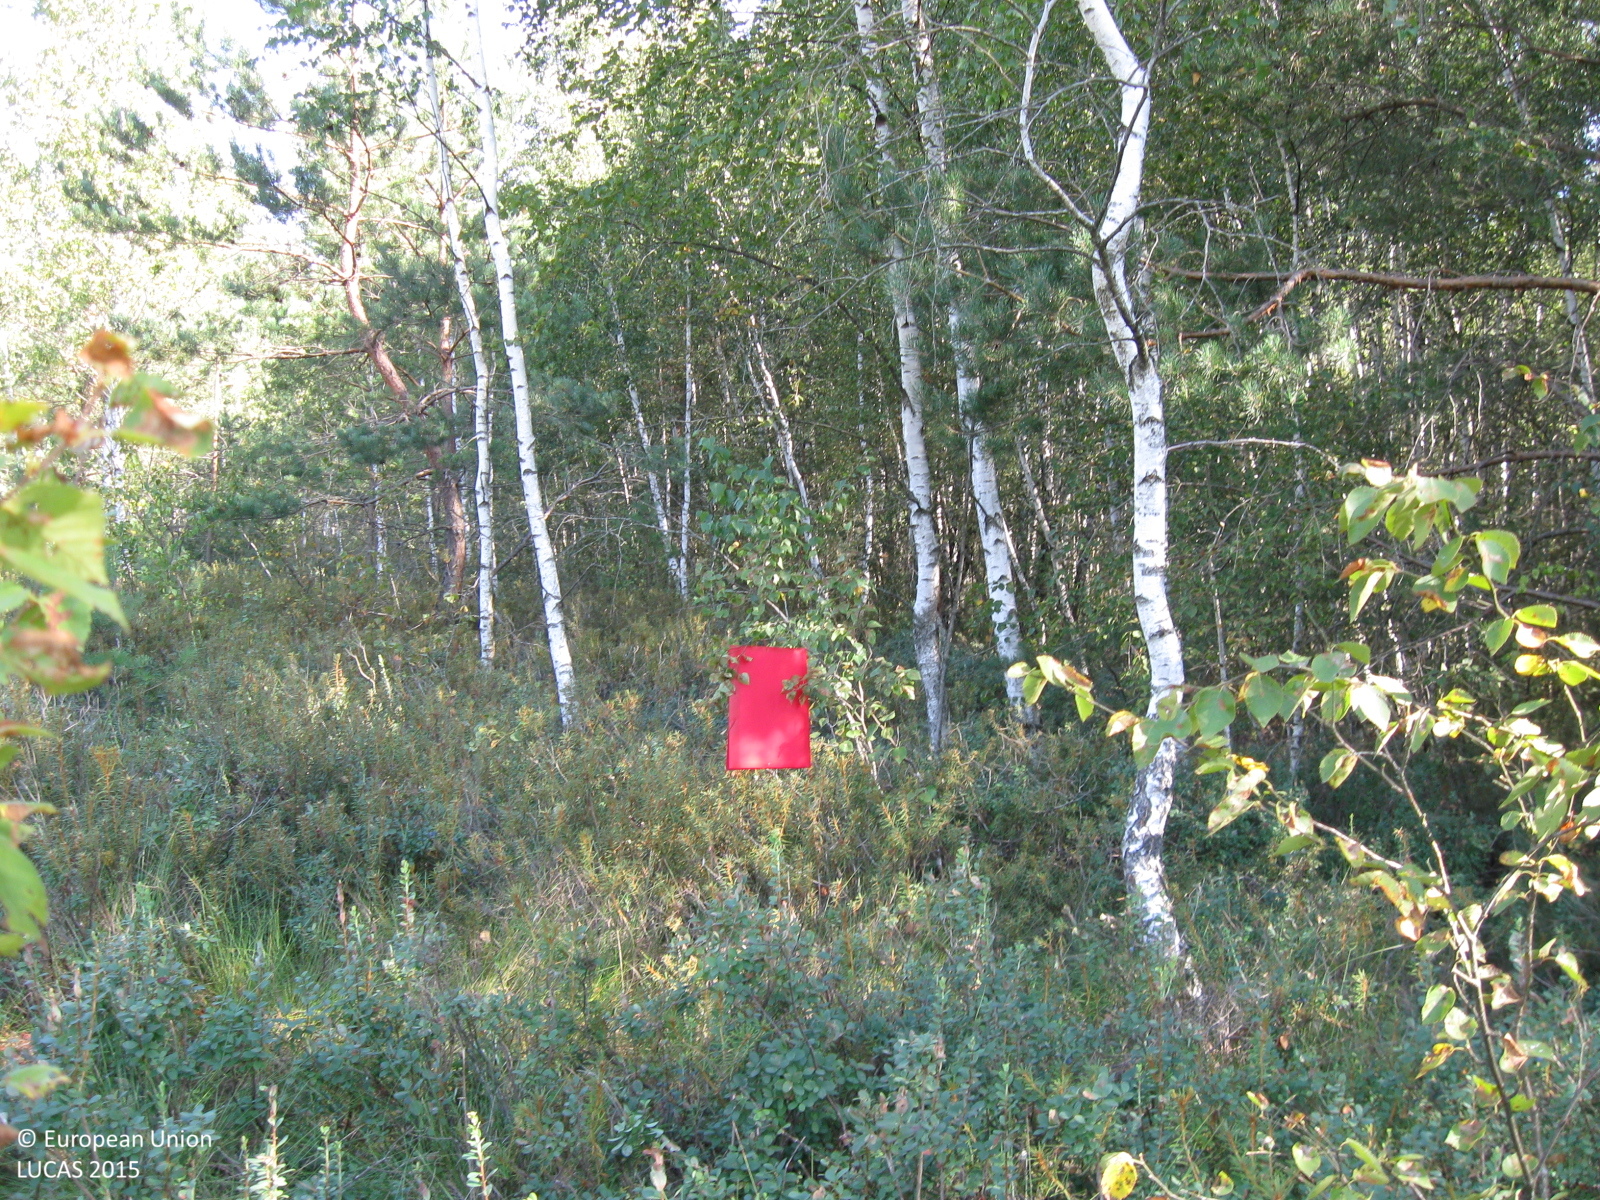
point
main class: Woodland
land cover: Pine dominated mixed woodland
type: mire and swamp forests
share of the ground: 50 - 75 %
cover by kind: broadleaved forest trees 35 %, shrubs 35 %, coniferous forest trees 15 %, herbaceous plants 10 %, lichens and mosses 5 %
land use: Forestry
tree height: > 5 m
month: August
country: LT
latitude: 55.1288
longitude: 22.7543
